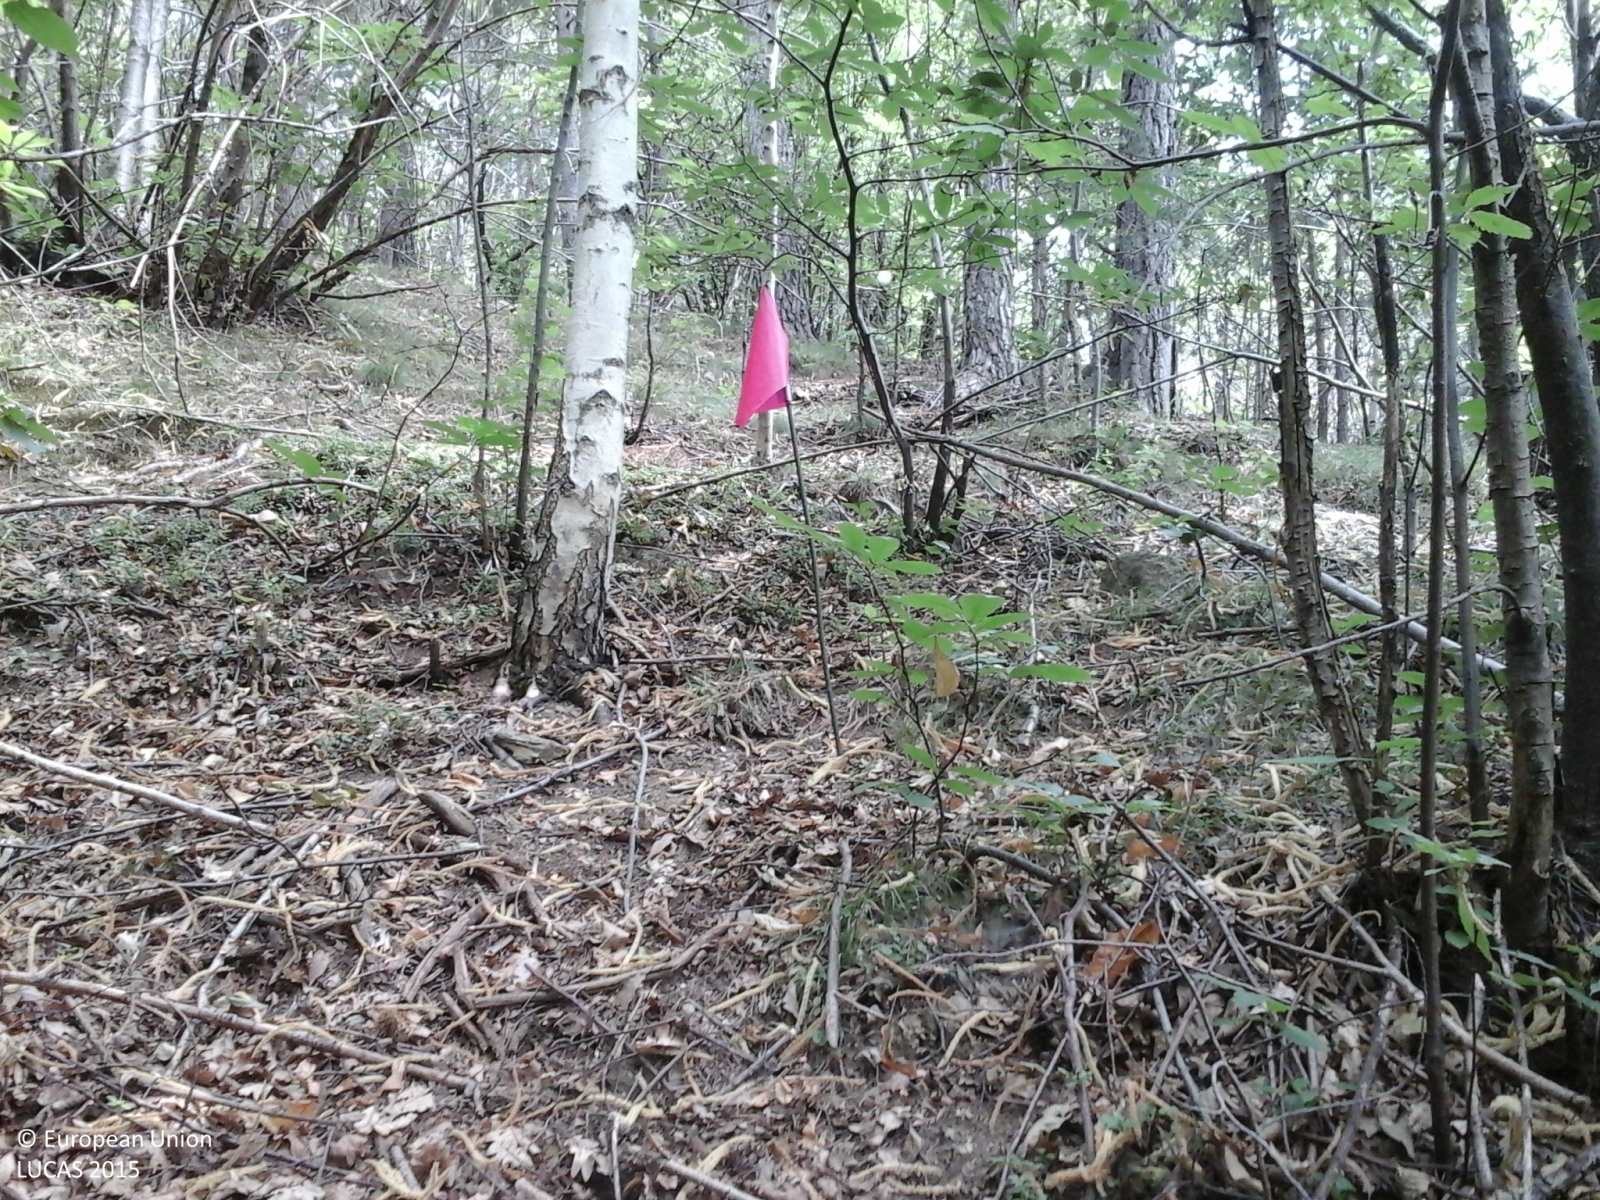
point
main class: Woodland
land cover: Broadleaved woodland
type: thermophilous deciduous forest
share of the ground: > 75 %
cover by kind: broadleaved forest trees 100 %
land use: Semi-natural and natural areas not in use
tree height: > 5 m
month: July
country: IT
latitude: 44.8923
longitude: 7.2825
